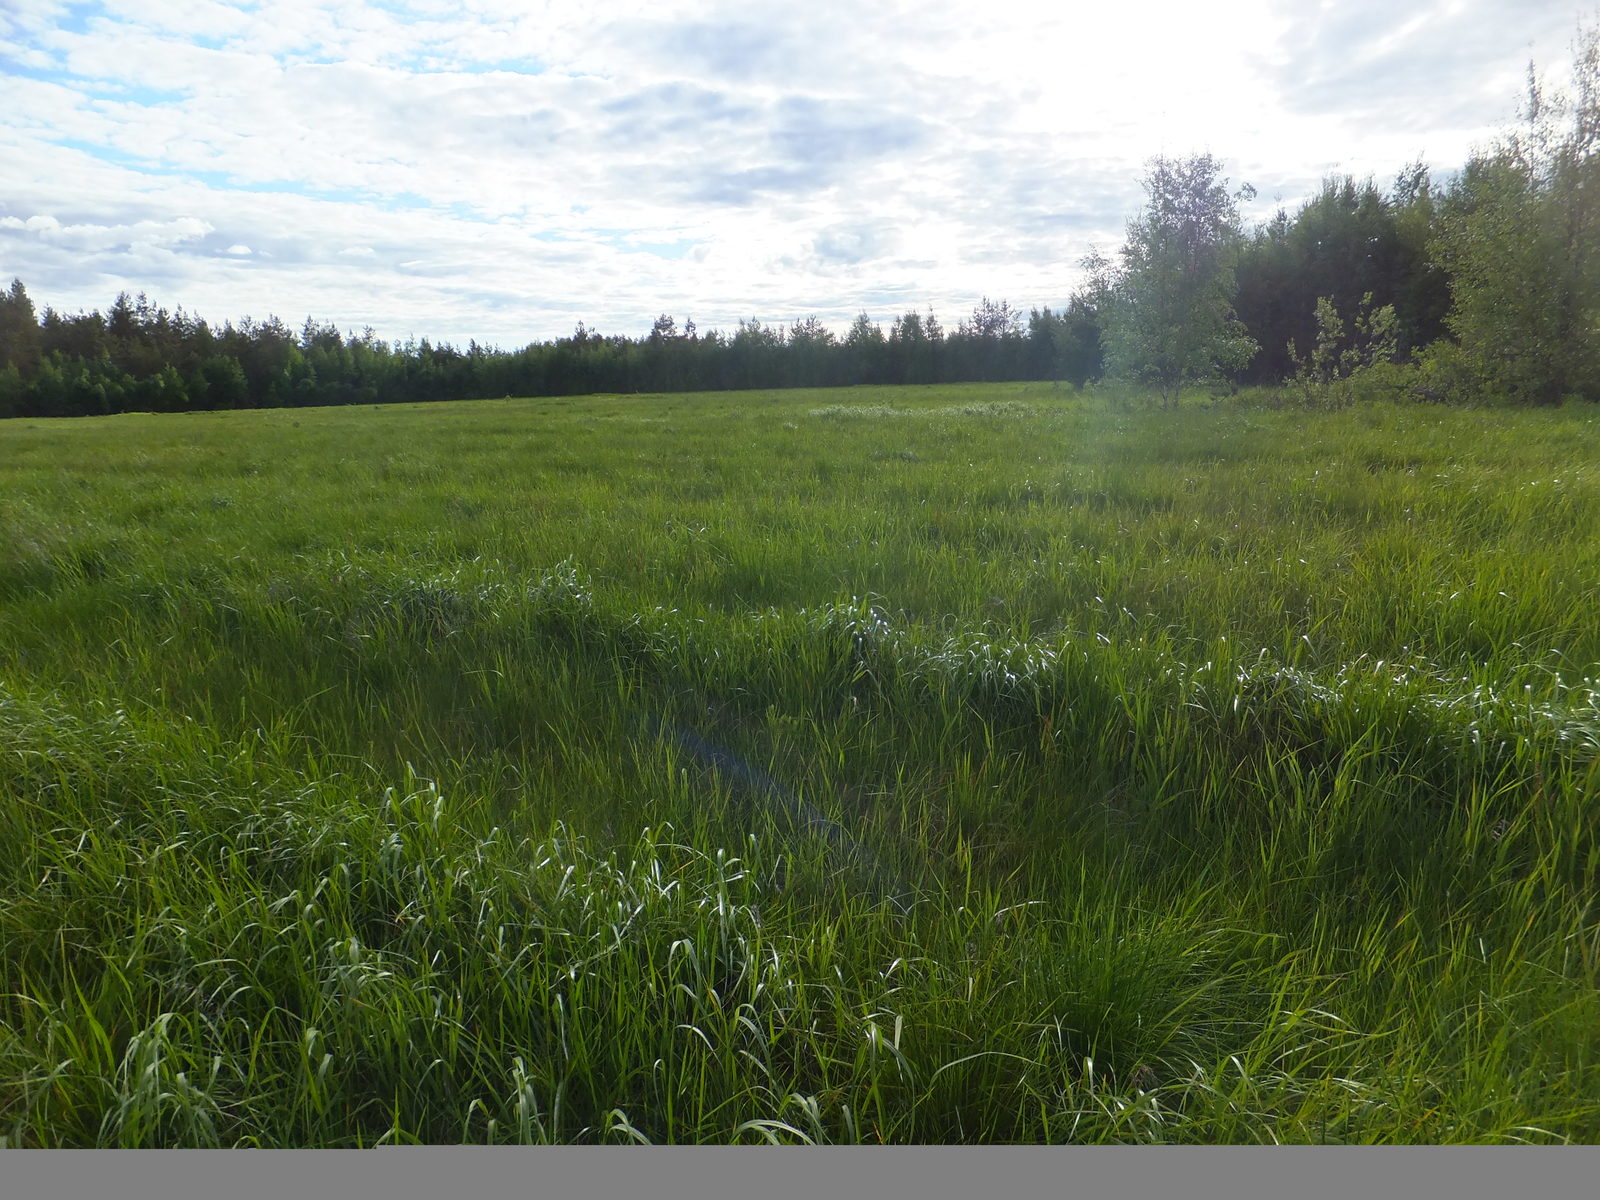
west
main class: Cropland
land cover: Temporary grasslands
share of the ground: > 75 %
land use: Agriculture (excluding fallow land and kitchen gardens)
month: June
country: FI
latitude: 63.6777
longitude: 24.2428
